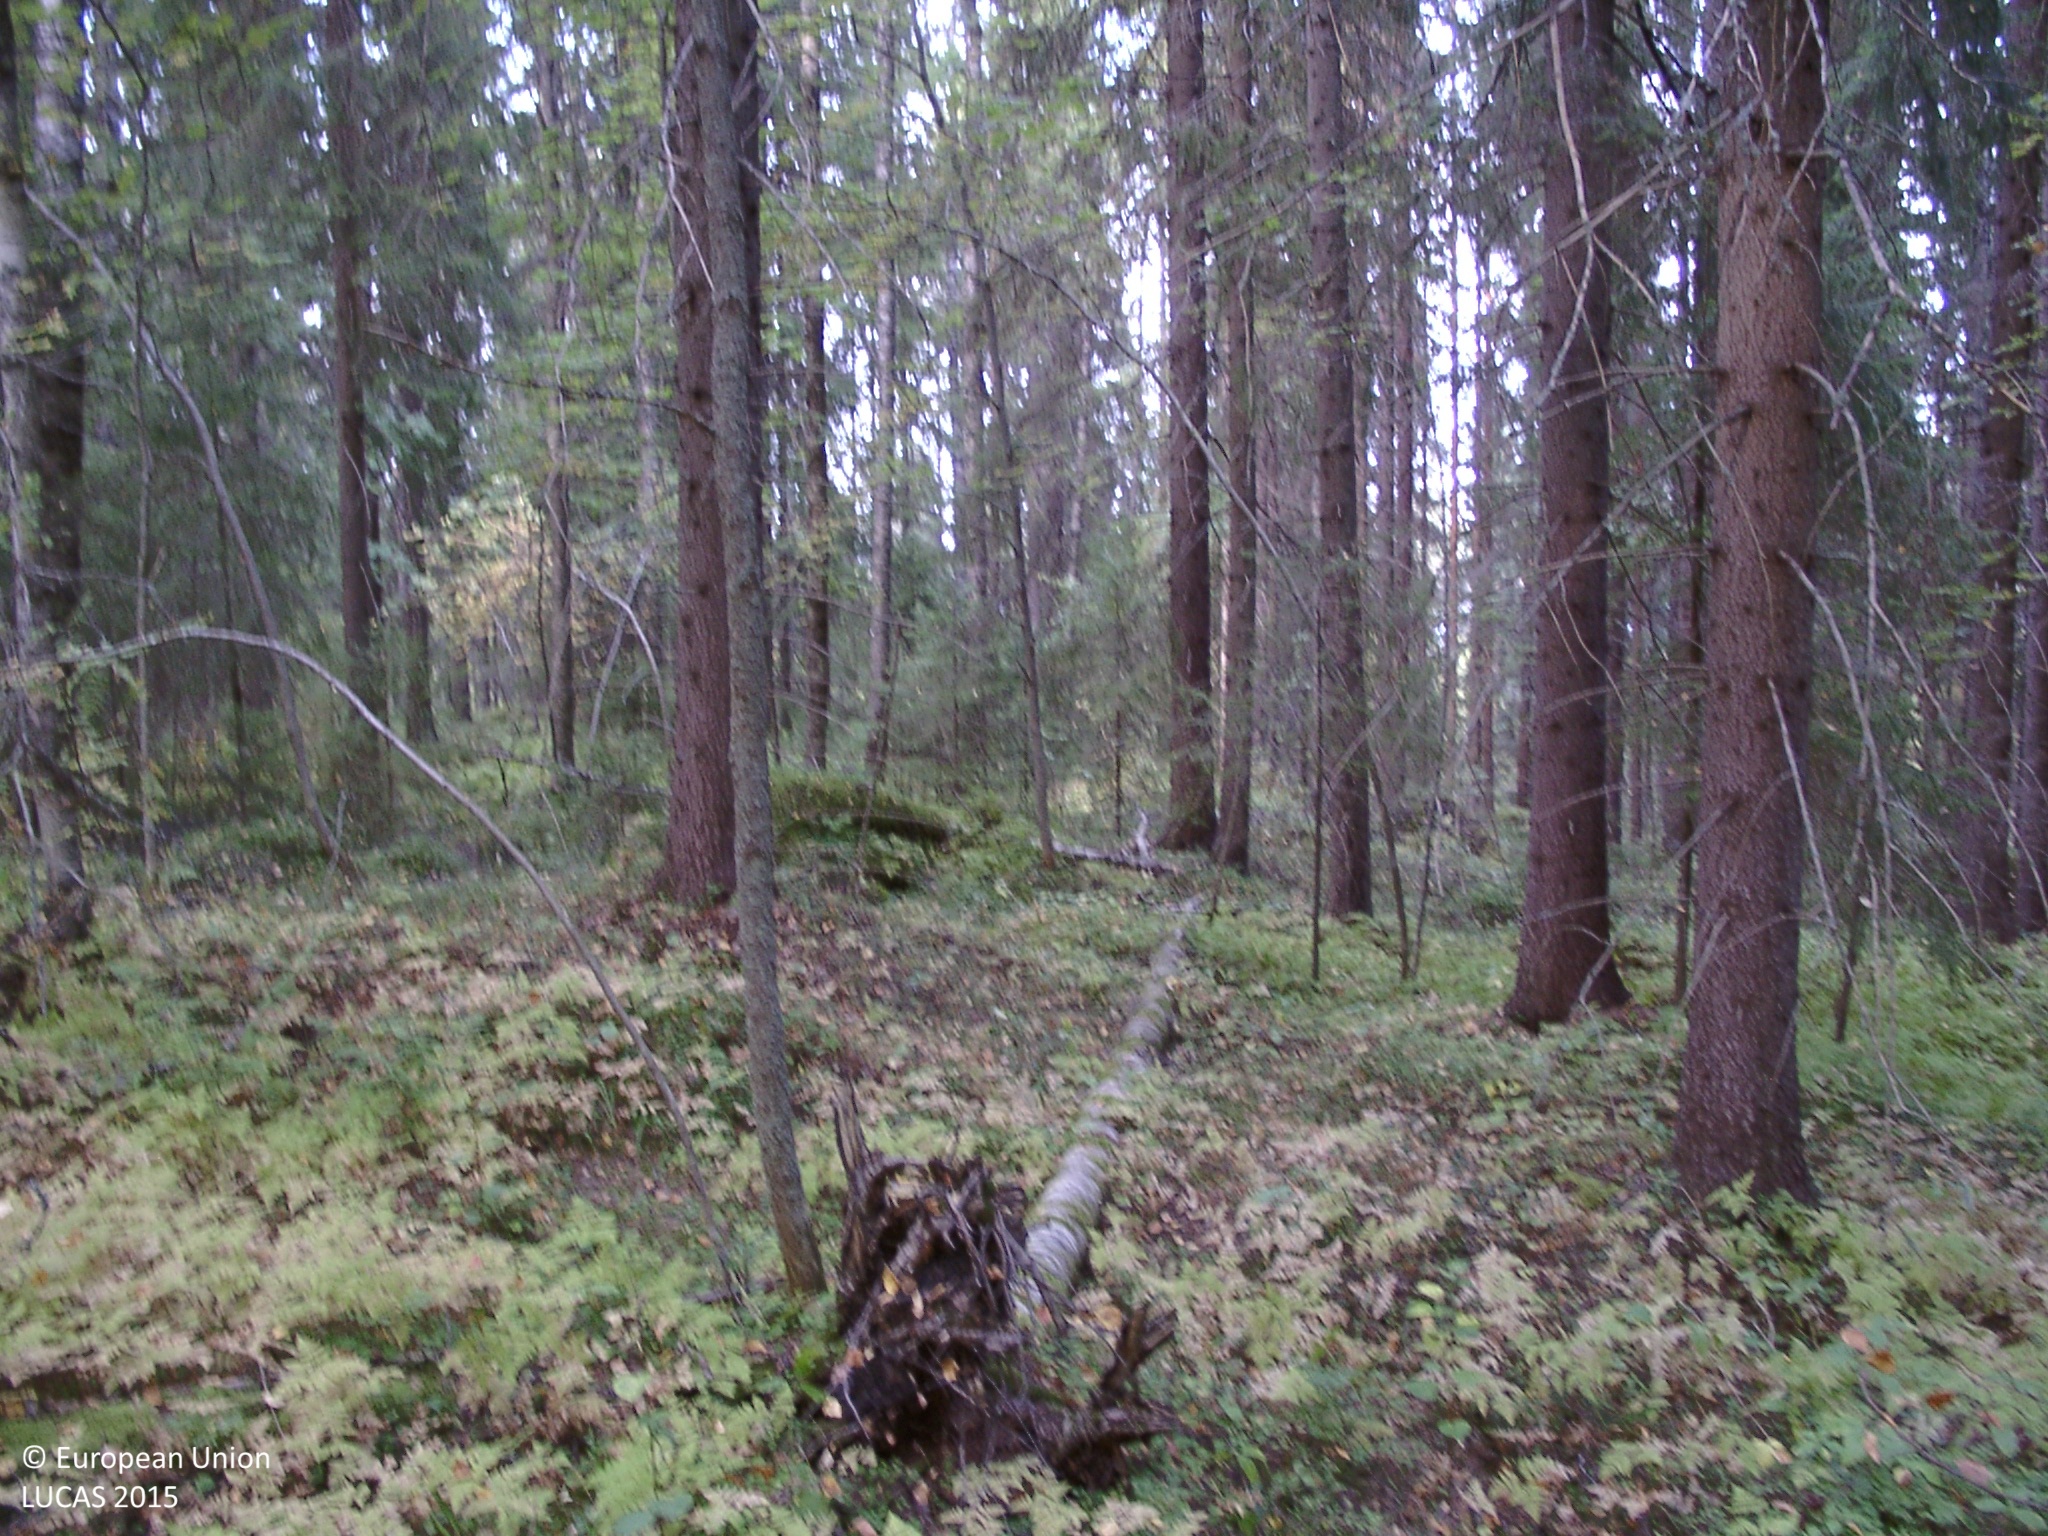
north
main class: Woodland
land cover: Spruce dominated mixed woodland
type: boreal forest
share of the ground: > 75 %
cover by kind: coniferous forest trees 45 %, broadleaved forest trees 40 %, herbaceous plants 10 %, lichens and mosses 5 %
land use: Forestry
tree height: > 5 m
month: September
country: FI
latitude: 62.6051
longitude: 25.7604
